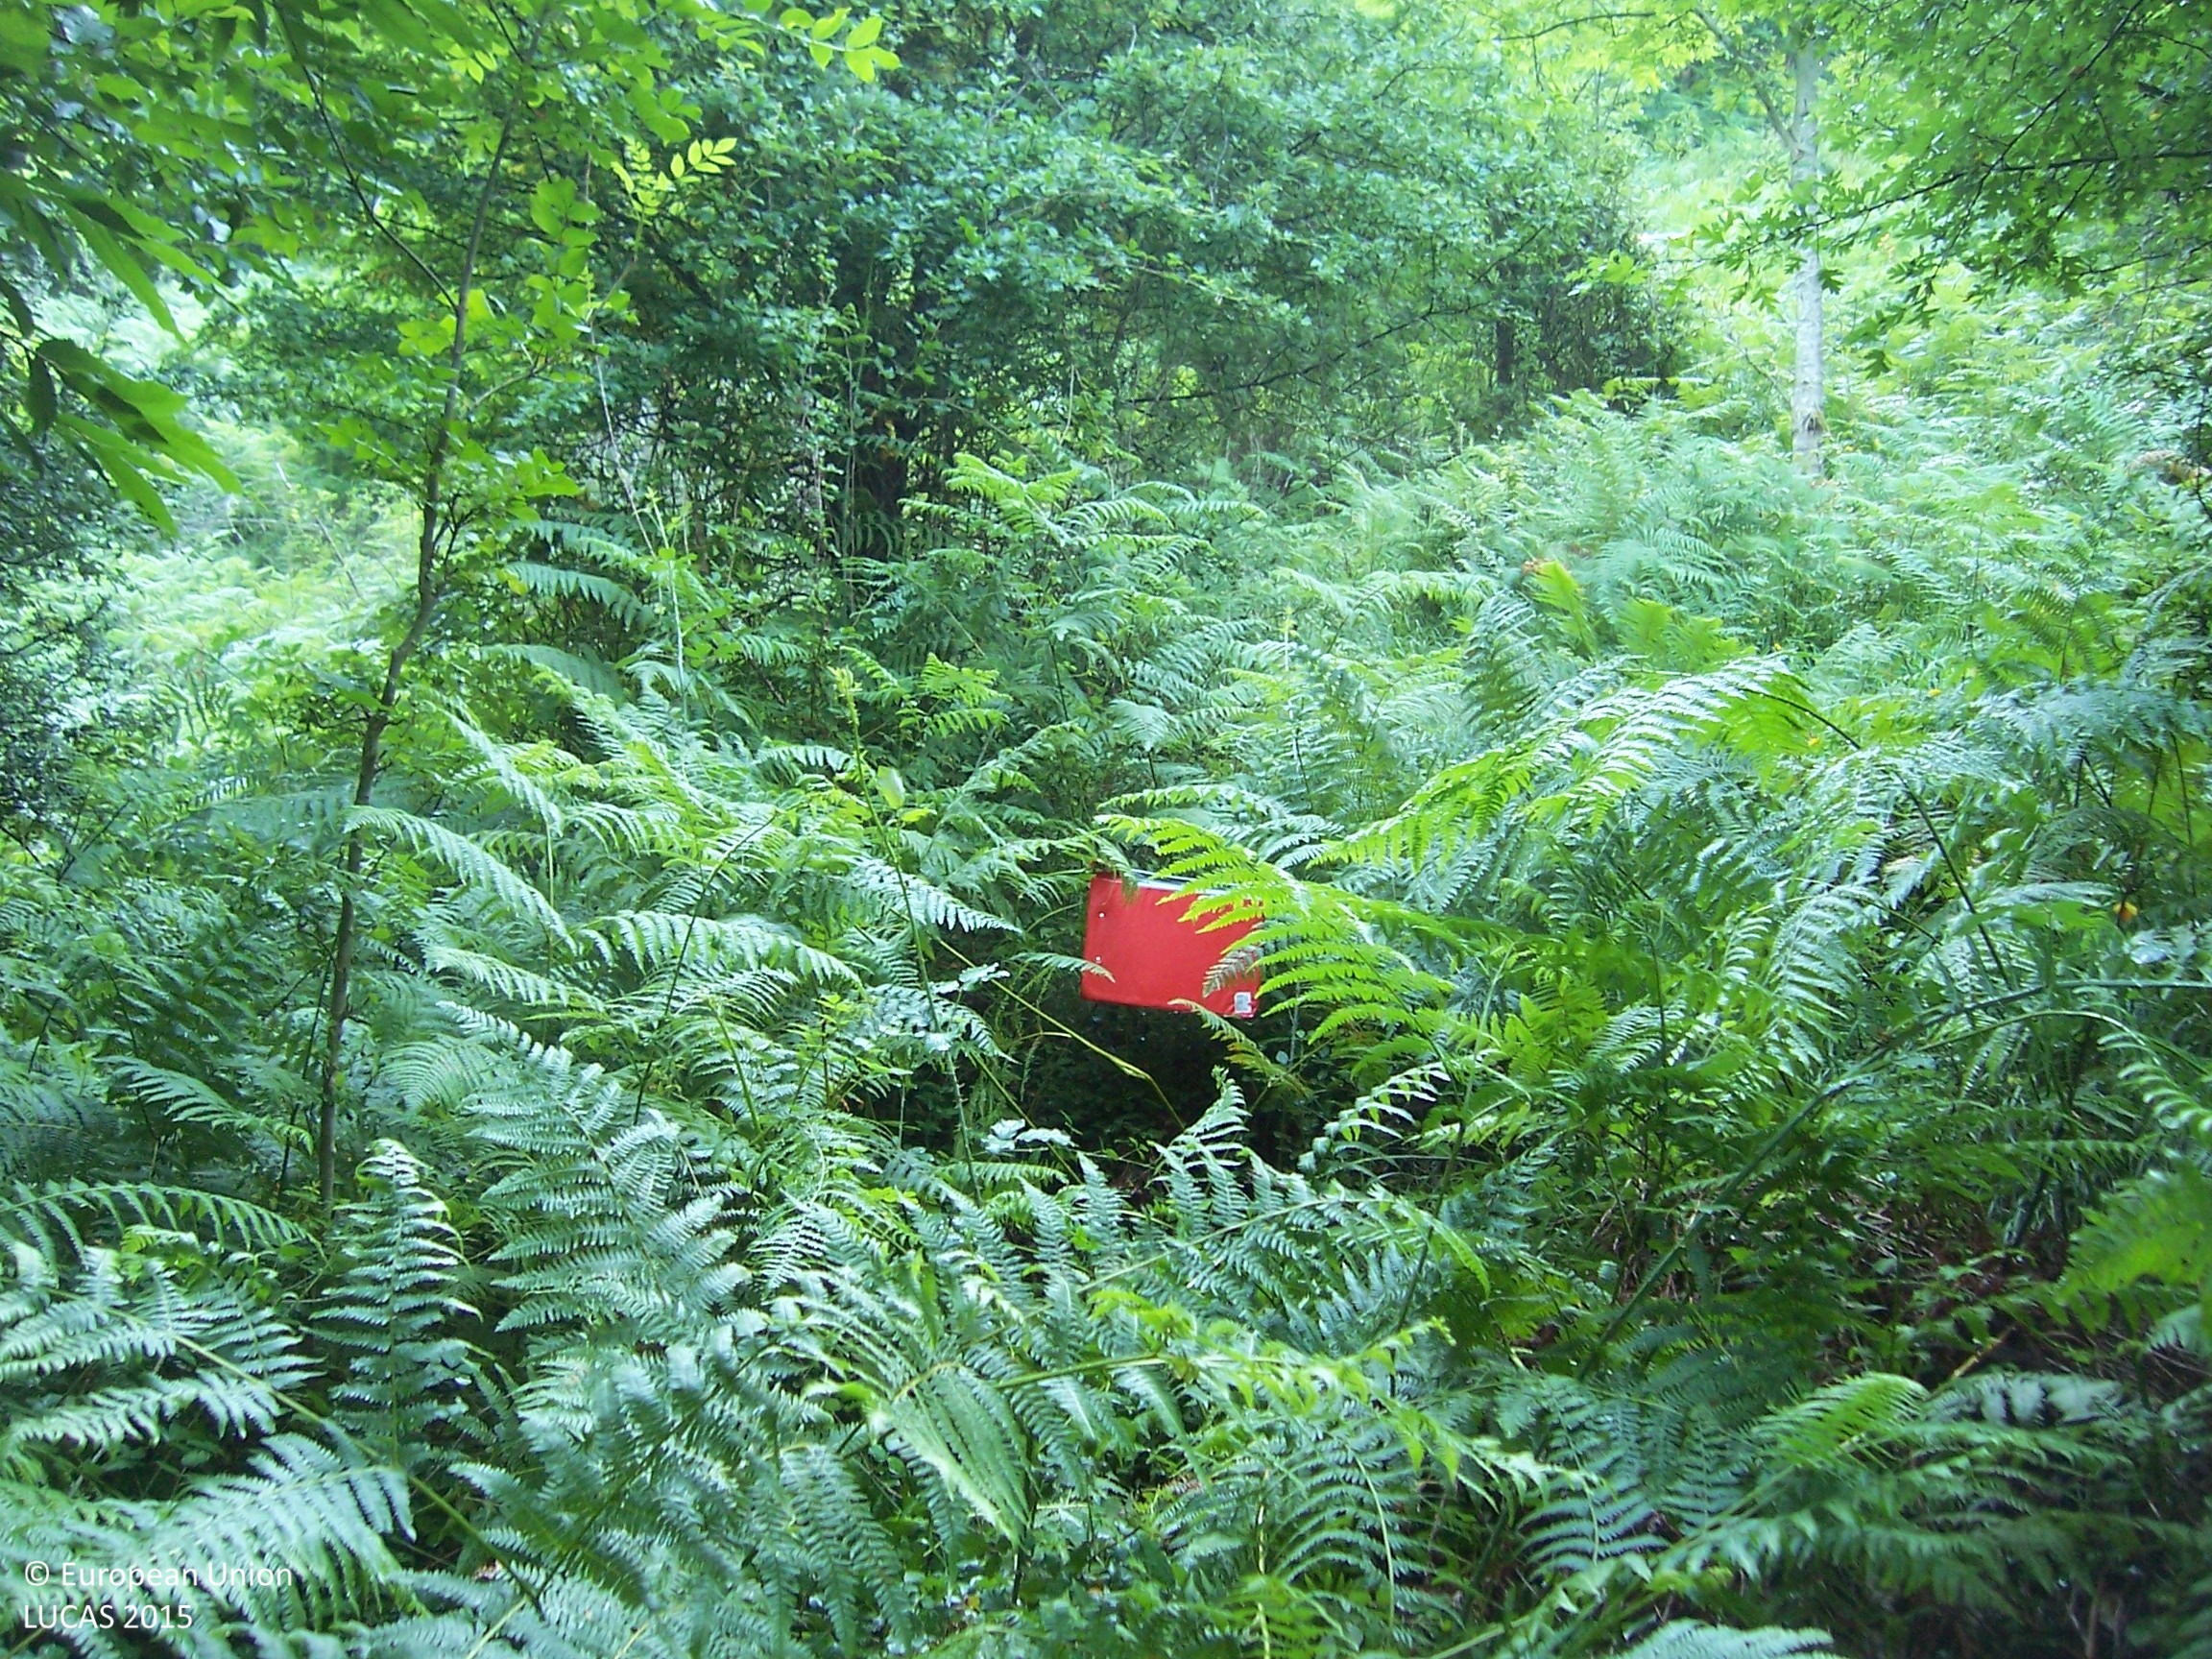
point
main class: Woodland
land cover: Broadleaved woodland
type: floodplain forest
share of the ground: > 75 %
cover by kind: broadleaved forest trees 100 %
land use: Semi-natural and natural areas not in use
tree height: > 5 m
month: July
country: ES
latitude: 42.9979
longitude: -1.5083
